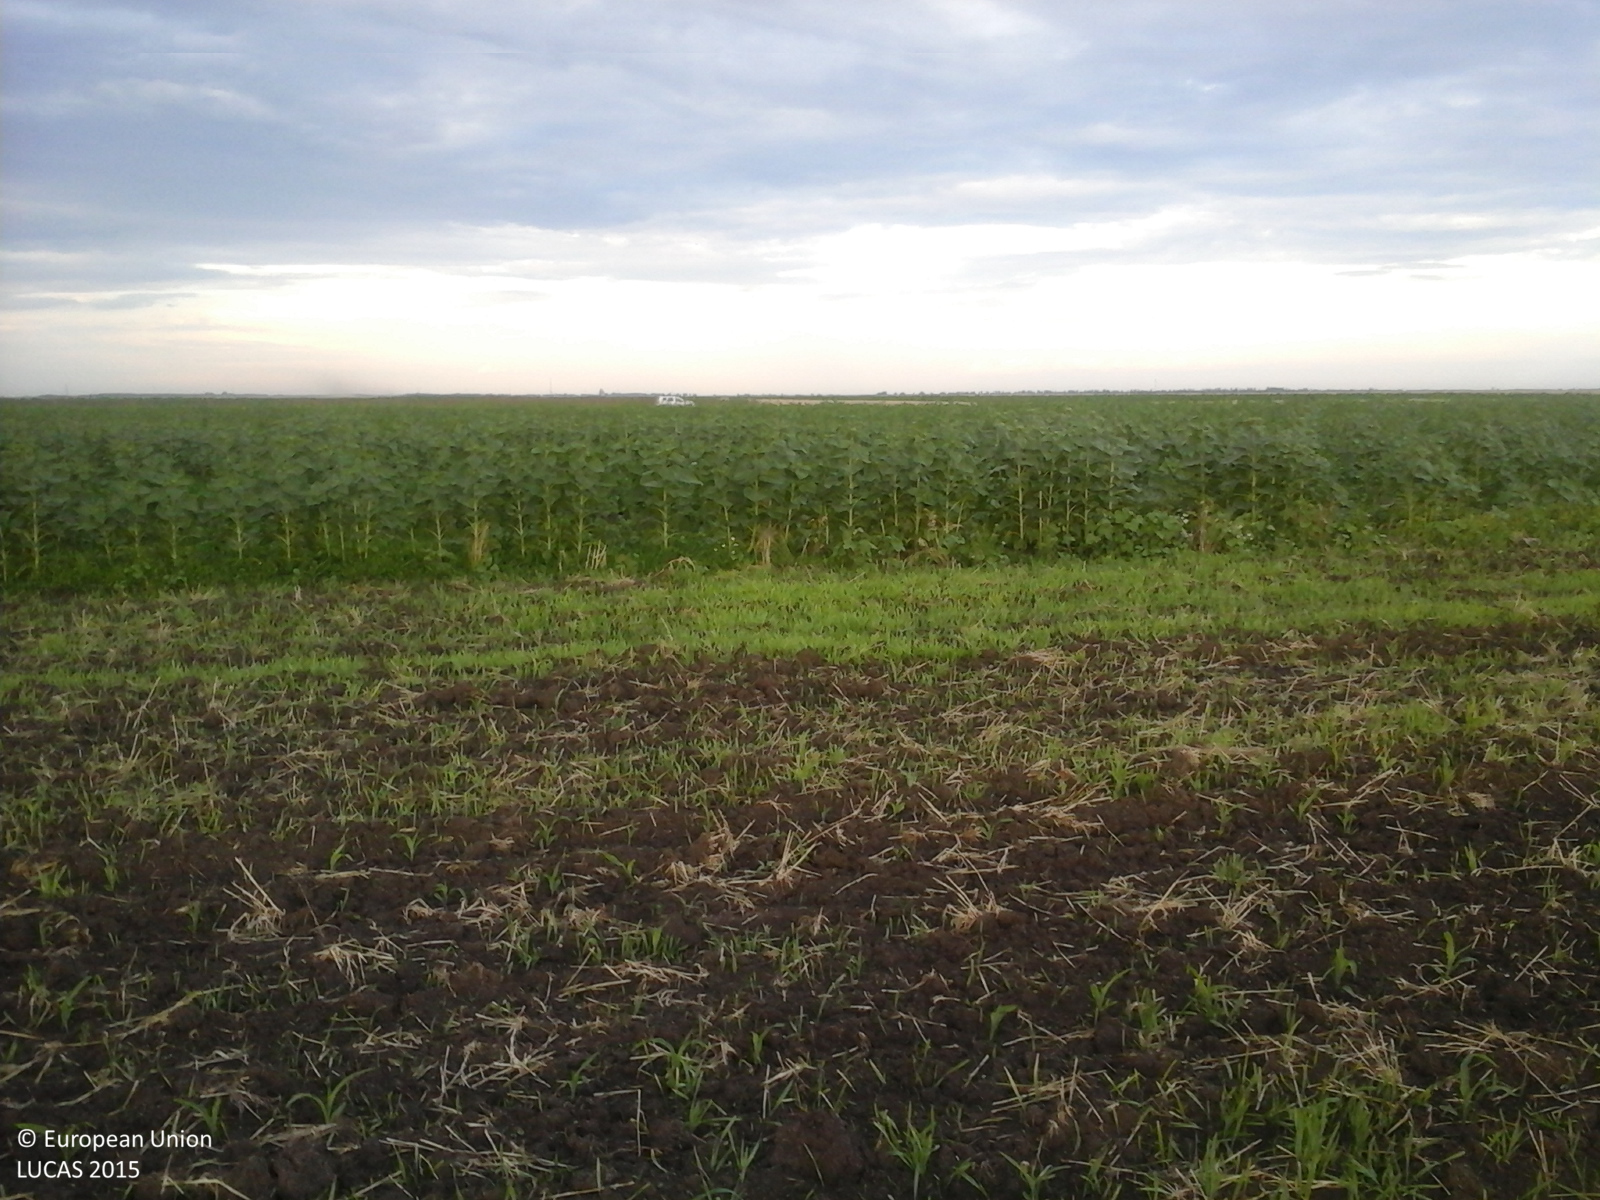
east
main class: Cropland
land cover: Maize
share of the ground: < 10 %
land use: Agriculture (excluding fallow land and kitchen gardens)
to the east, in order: Maize; Sunflower; Spontaneously vegetated surfaces; Tracks; Maize
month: July
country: RO
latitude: 44.3705
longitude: 24.8728
